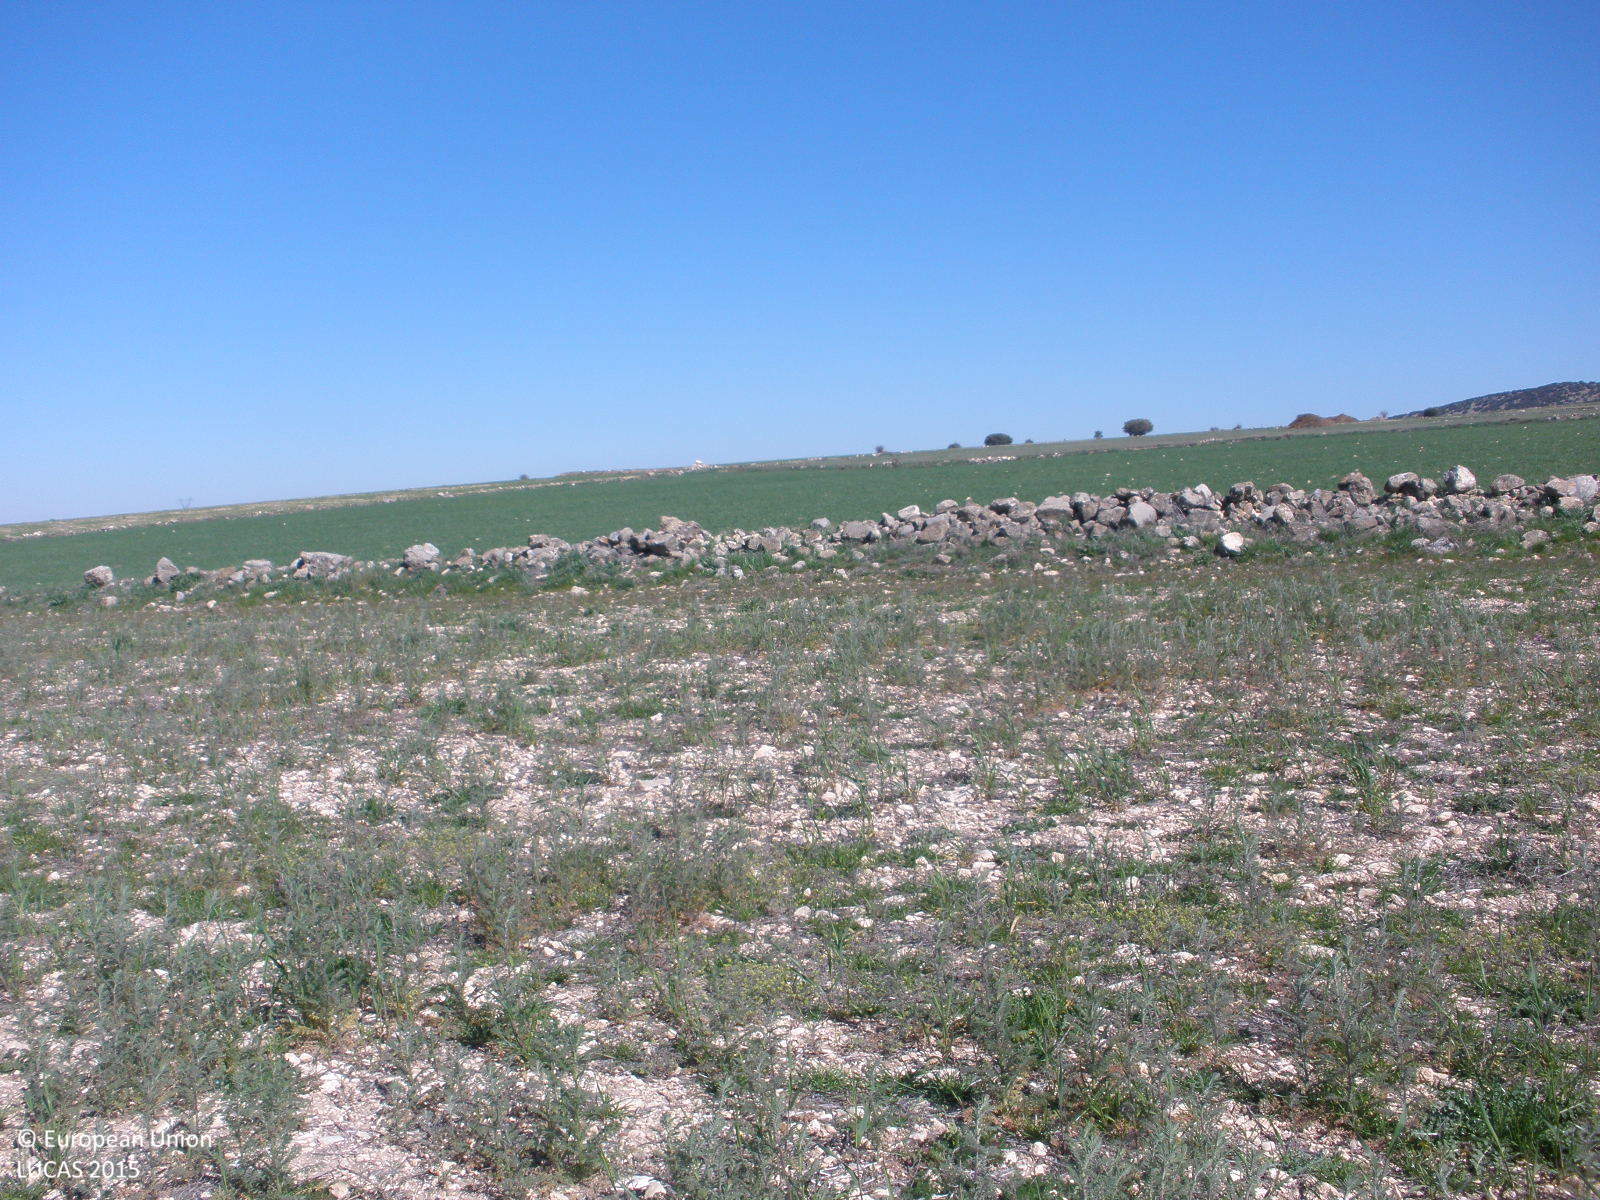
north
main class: Grassland
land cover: Spontaneously vegetated surfaces
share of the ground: 50 - 75 %
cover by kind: herbaceous plants 75 %, unconsolidated bare surface 25 %
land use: Agriculture (excluding fallow land and kitchen gardens)
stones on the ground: 25 - 50 %
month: April
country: ES
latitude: 40.6897
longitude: -1.2926
